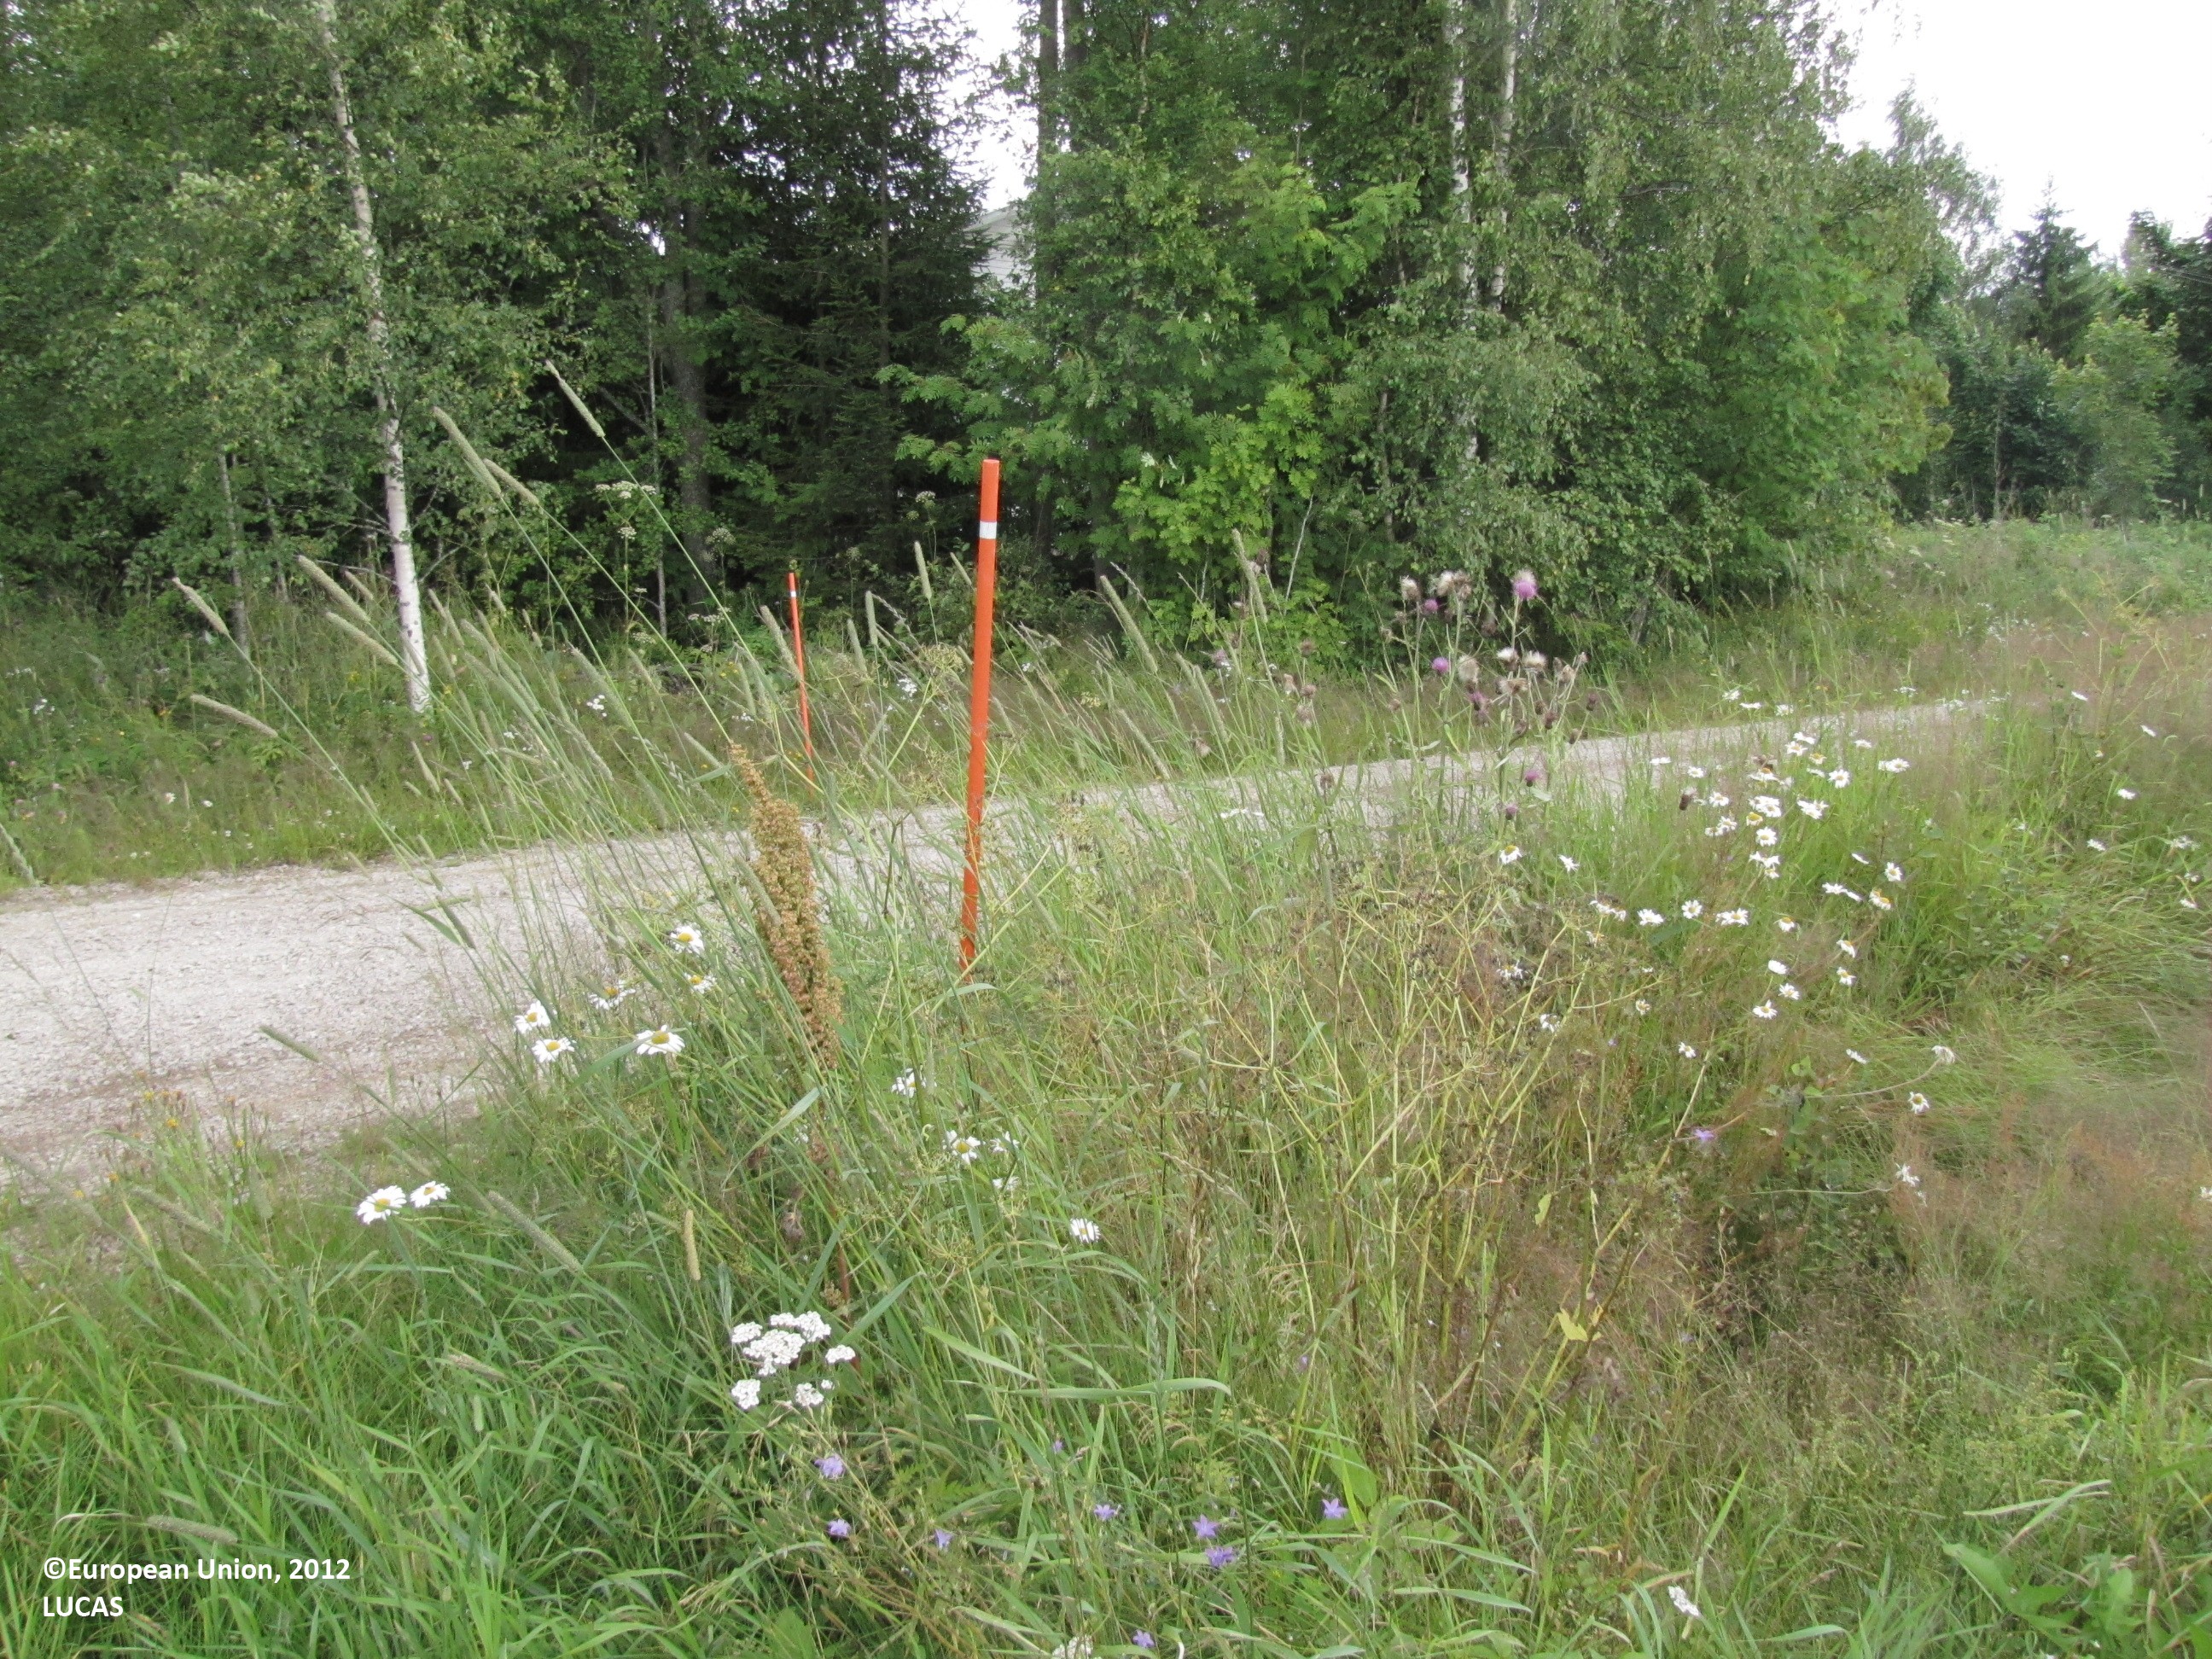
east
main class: Cropland
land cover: Oats
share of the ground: > 75 %
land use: Agriculture (excluding fallow land and kitchen gardens)
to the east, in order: Oats; Ditches and canals; Oats; Grass margins; Ditches and canals; Grass margins; Paved roads, cycling and walking lanes; Ditches and canals; Electric lines; Broadleaved woodland; Grassland without tree/shrub cover; Broadleaved woodland
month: July
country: FI
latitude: 61.9950
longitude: 22.9526
